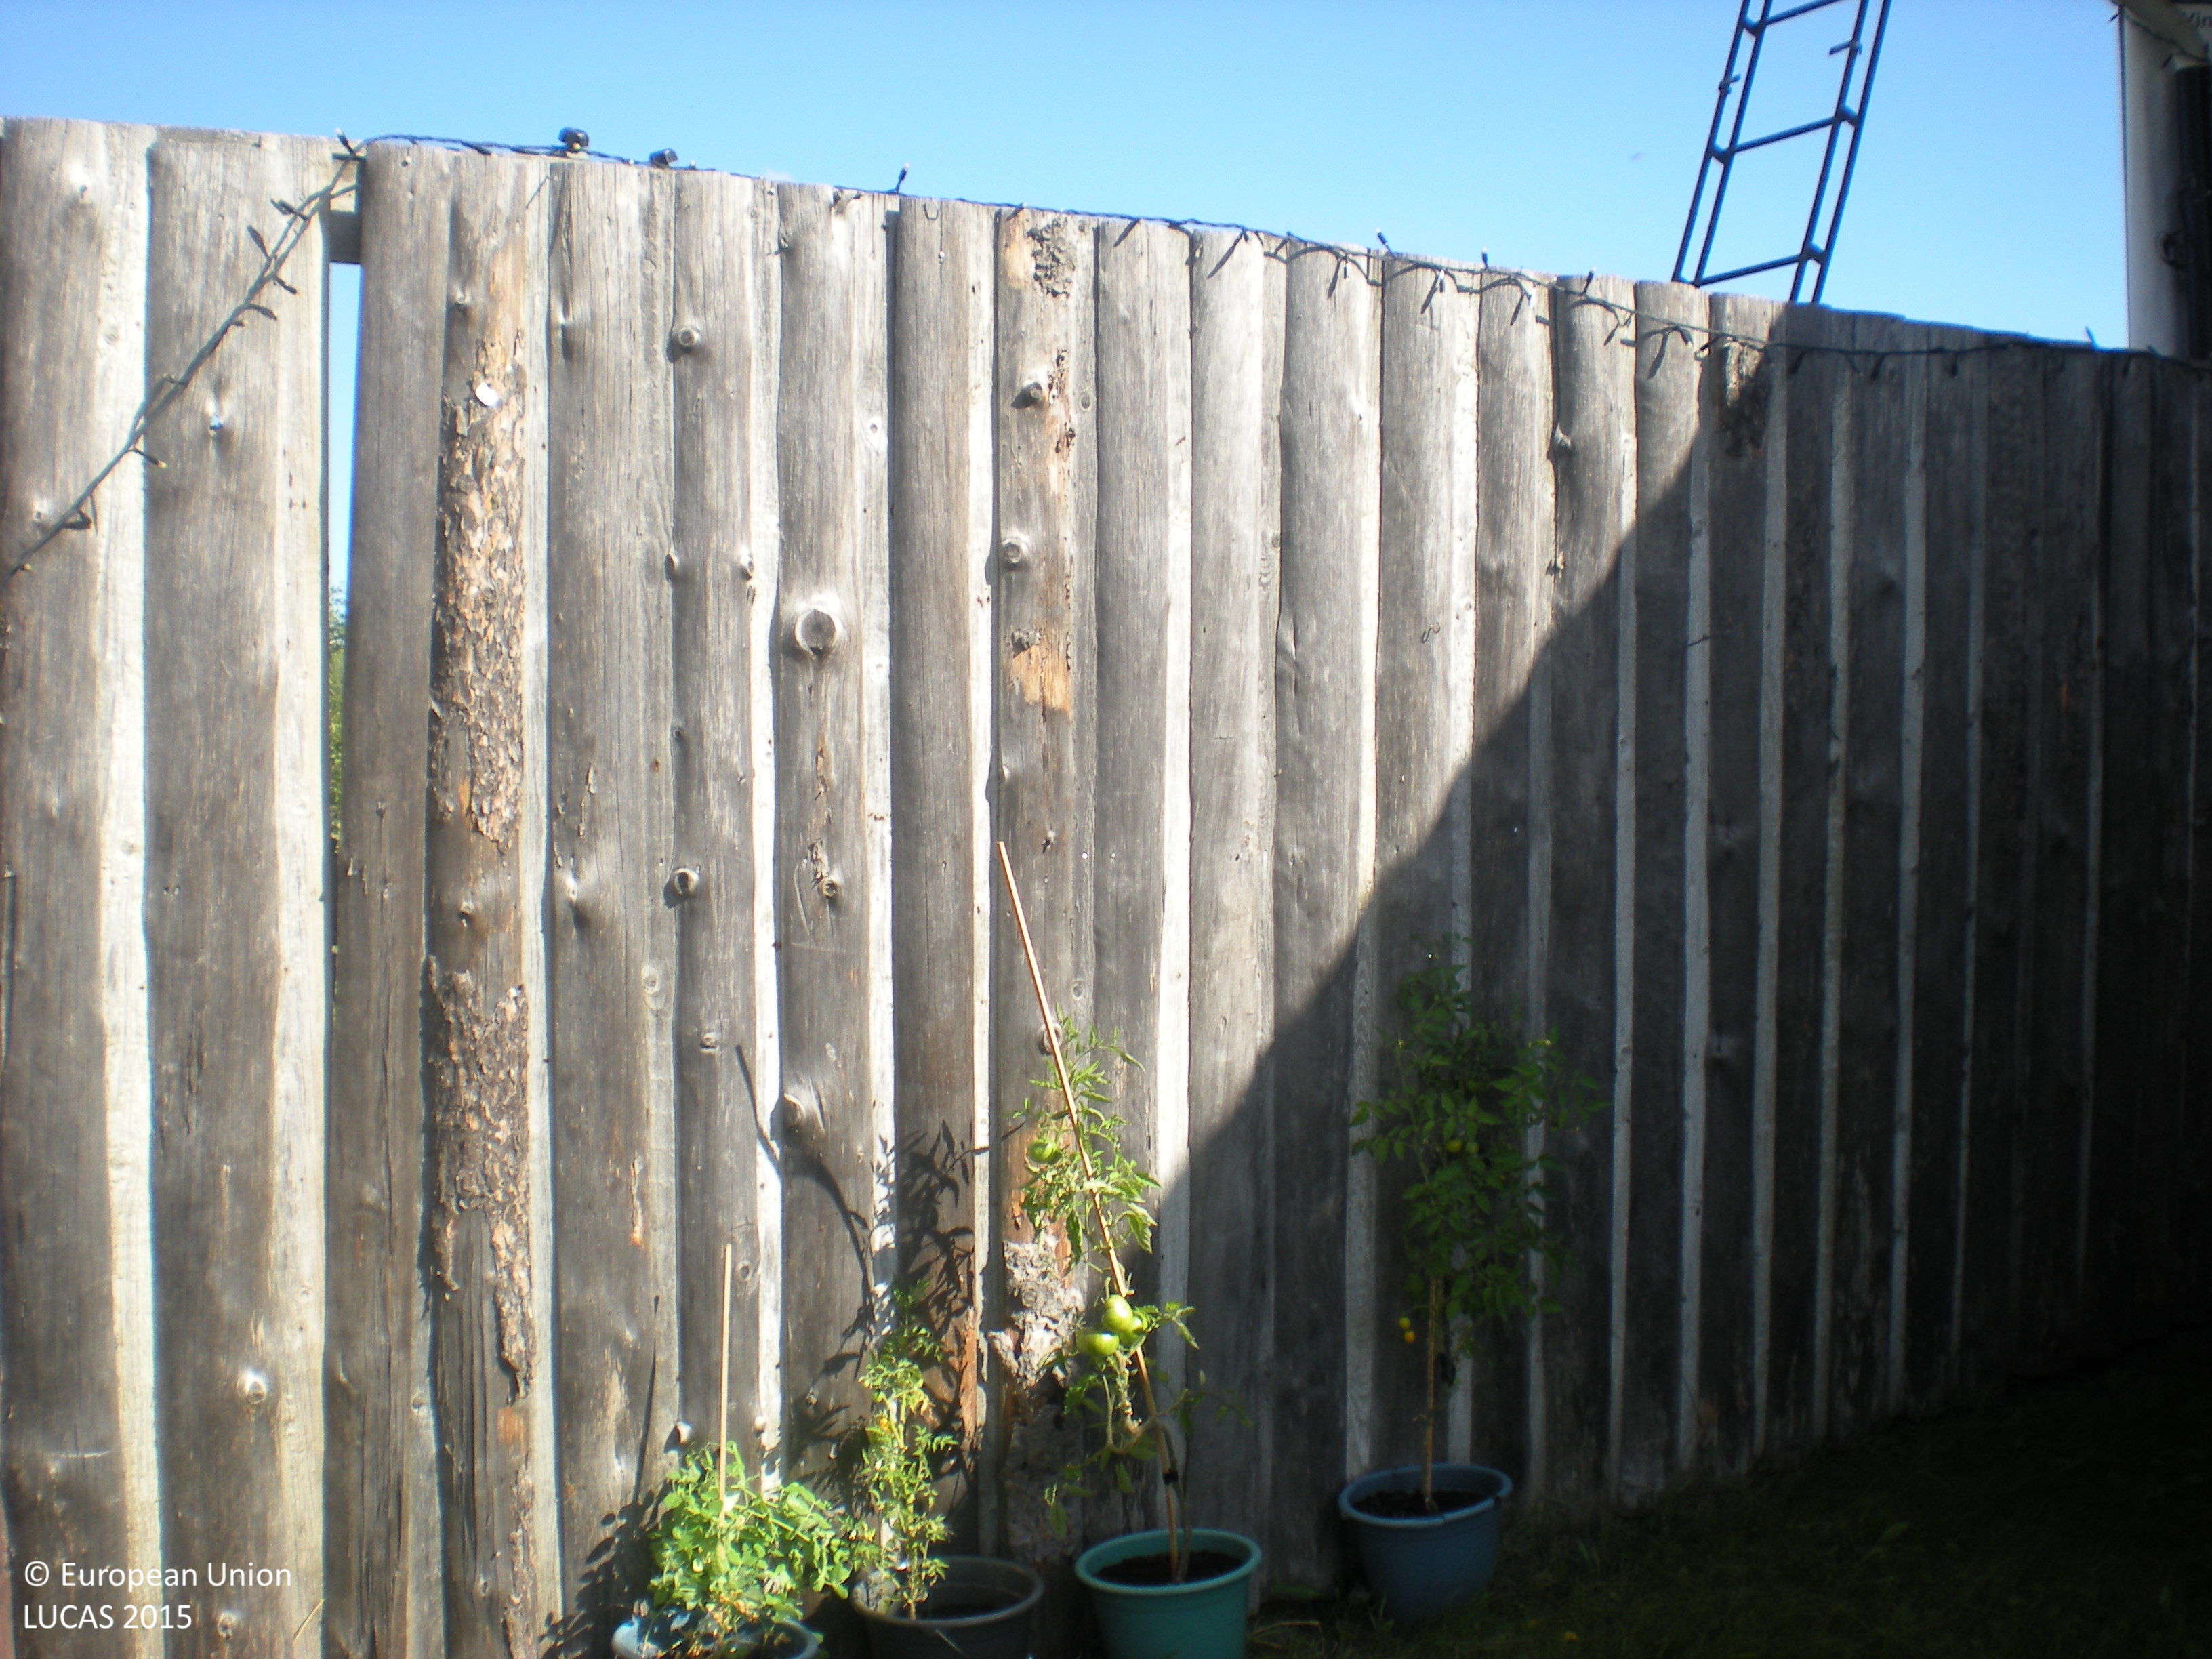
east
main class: Grassland
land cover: Grassland without tree/shrub cover
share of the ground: > 75 %
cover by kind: herbaceous plants 100 %
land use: Residential
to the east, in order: Grassland without tree/shrub cover; Artificial constructions in urban areas; Grassland with sparse tree/shrub cover; Grassland without tree/shrub cover; Ditches and canals; Grassland without tree/shrub cover; Barley; Grass margins; Ditches and canals; Grassland without tree/shrub cover; Spruce dominated mixed woodland; Artificial constructions in urban areas
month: August
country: SE
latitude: 60.5057
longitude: 16.7809
